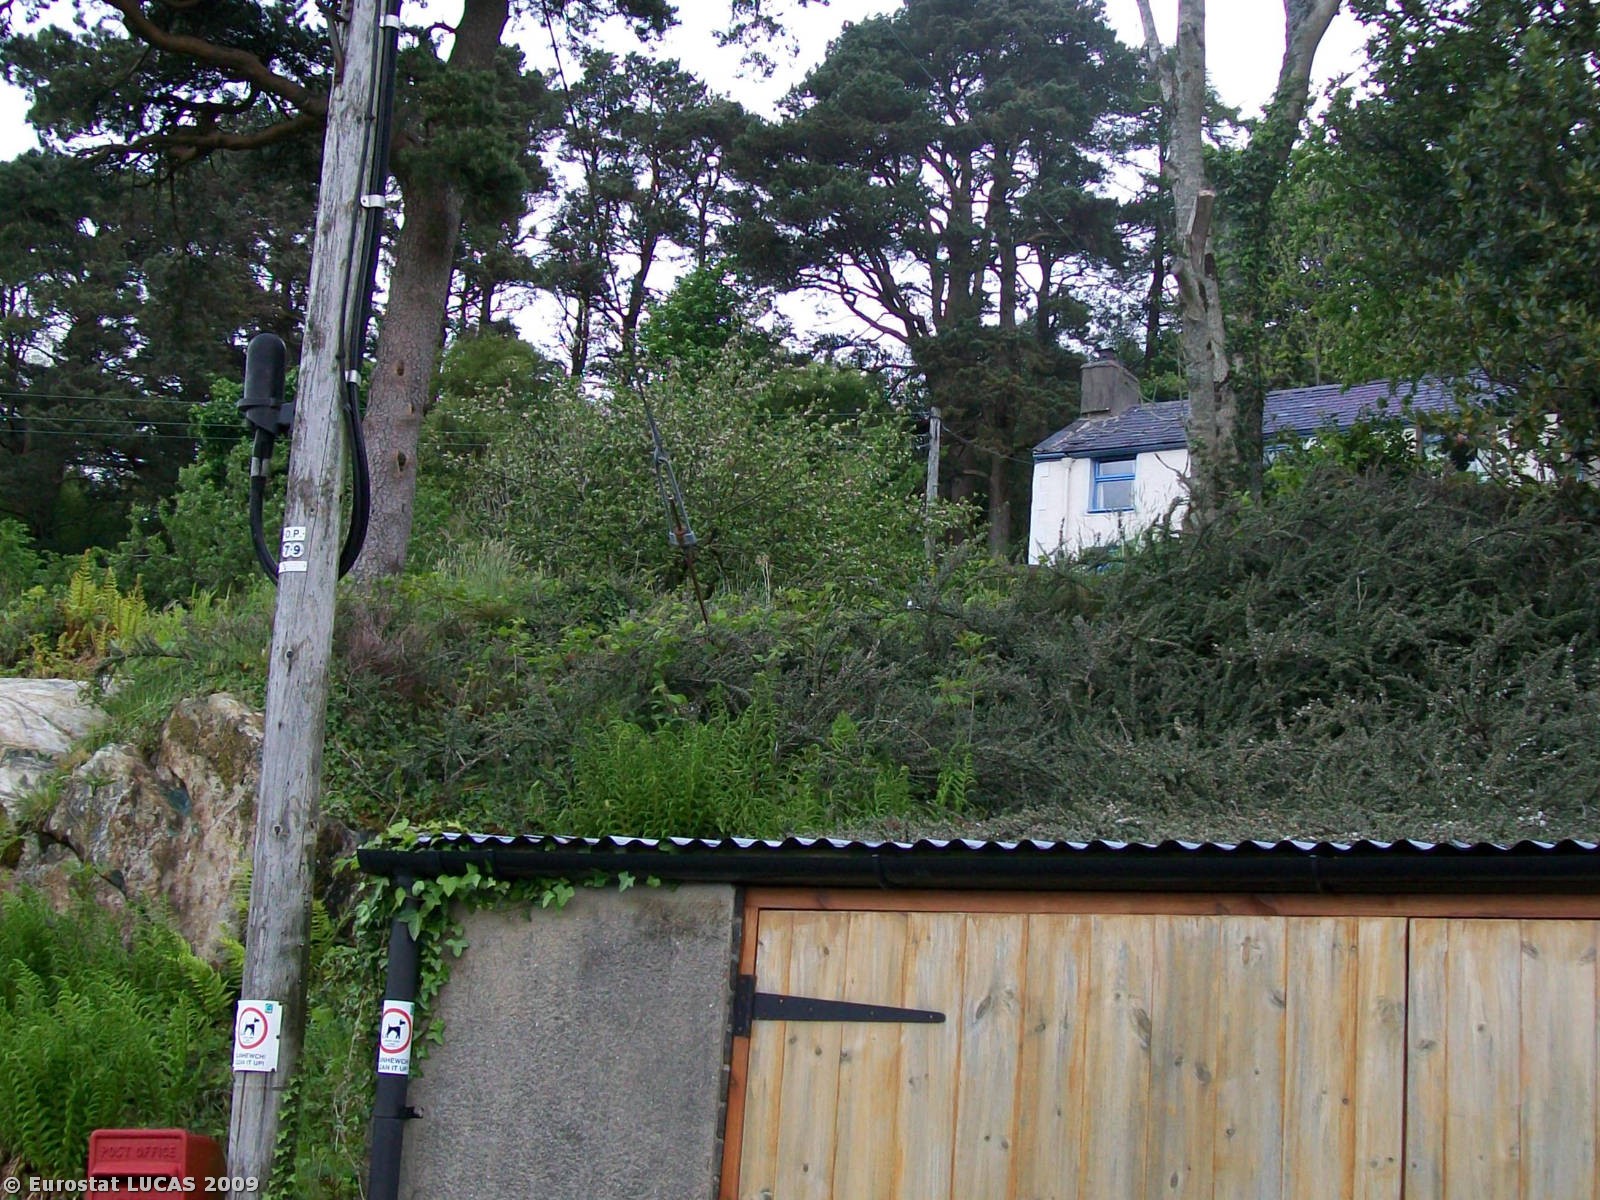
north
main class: Woodland
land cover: Broadleaved woodland
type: acidophilous oak and oak-birch forest
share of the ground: > 75 %
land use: Unused
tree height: > 5 m
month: May
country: GB
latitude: 53.1337
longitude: -4.1321
